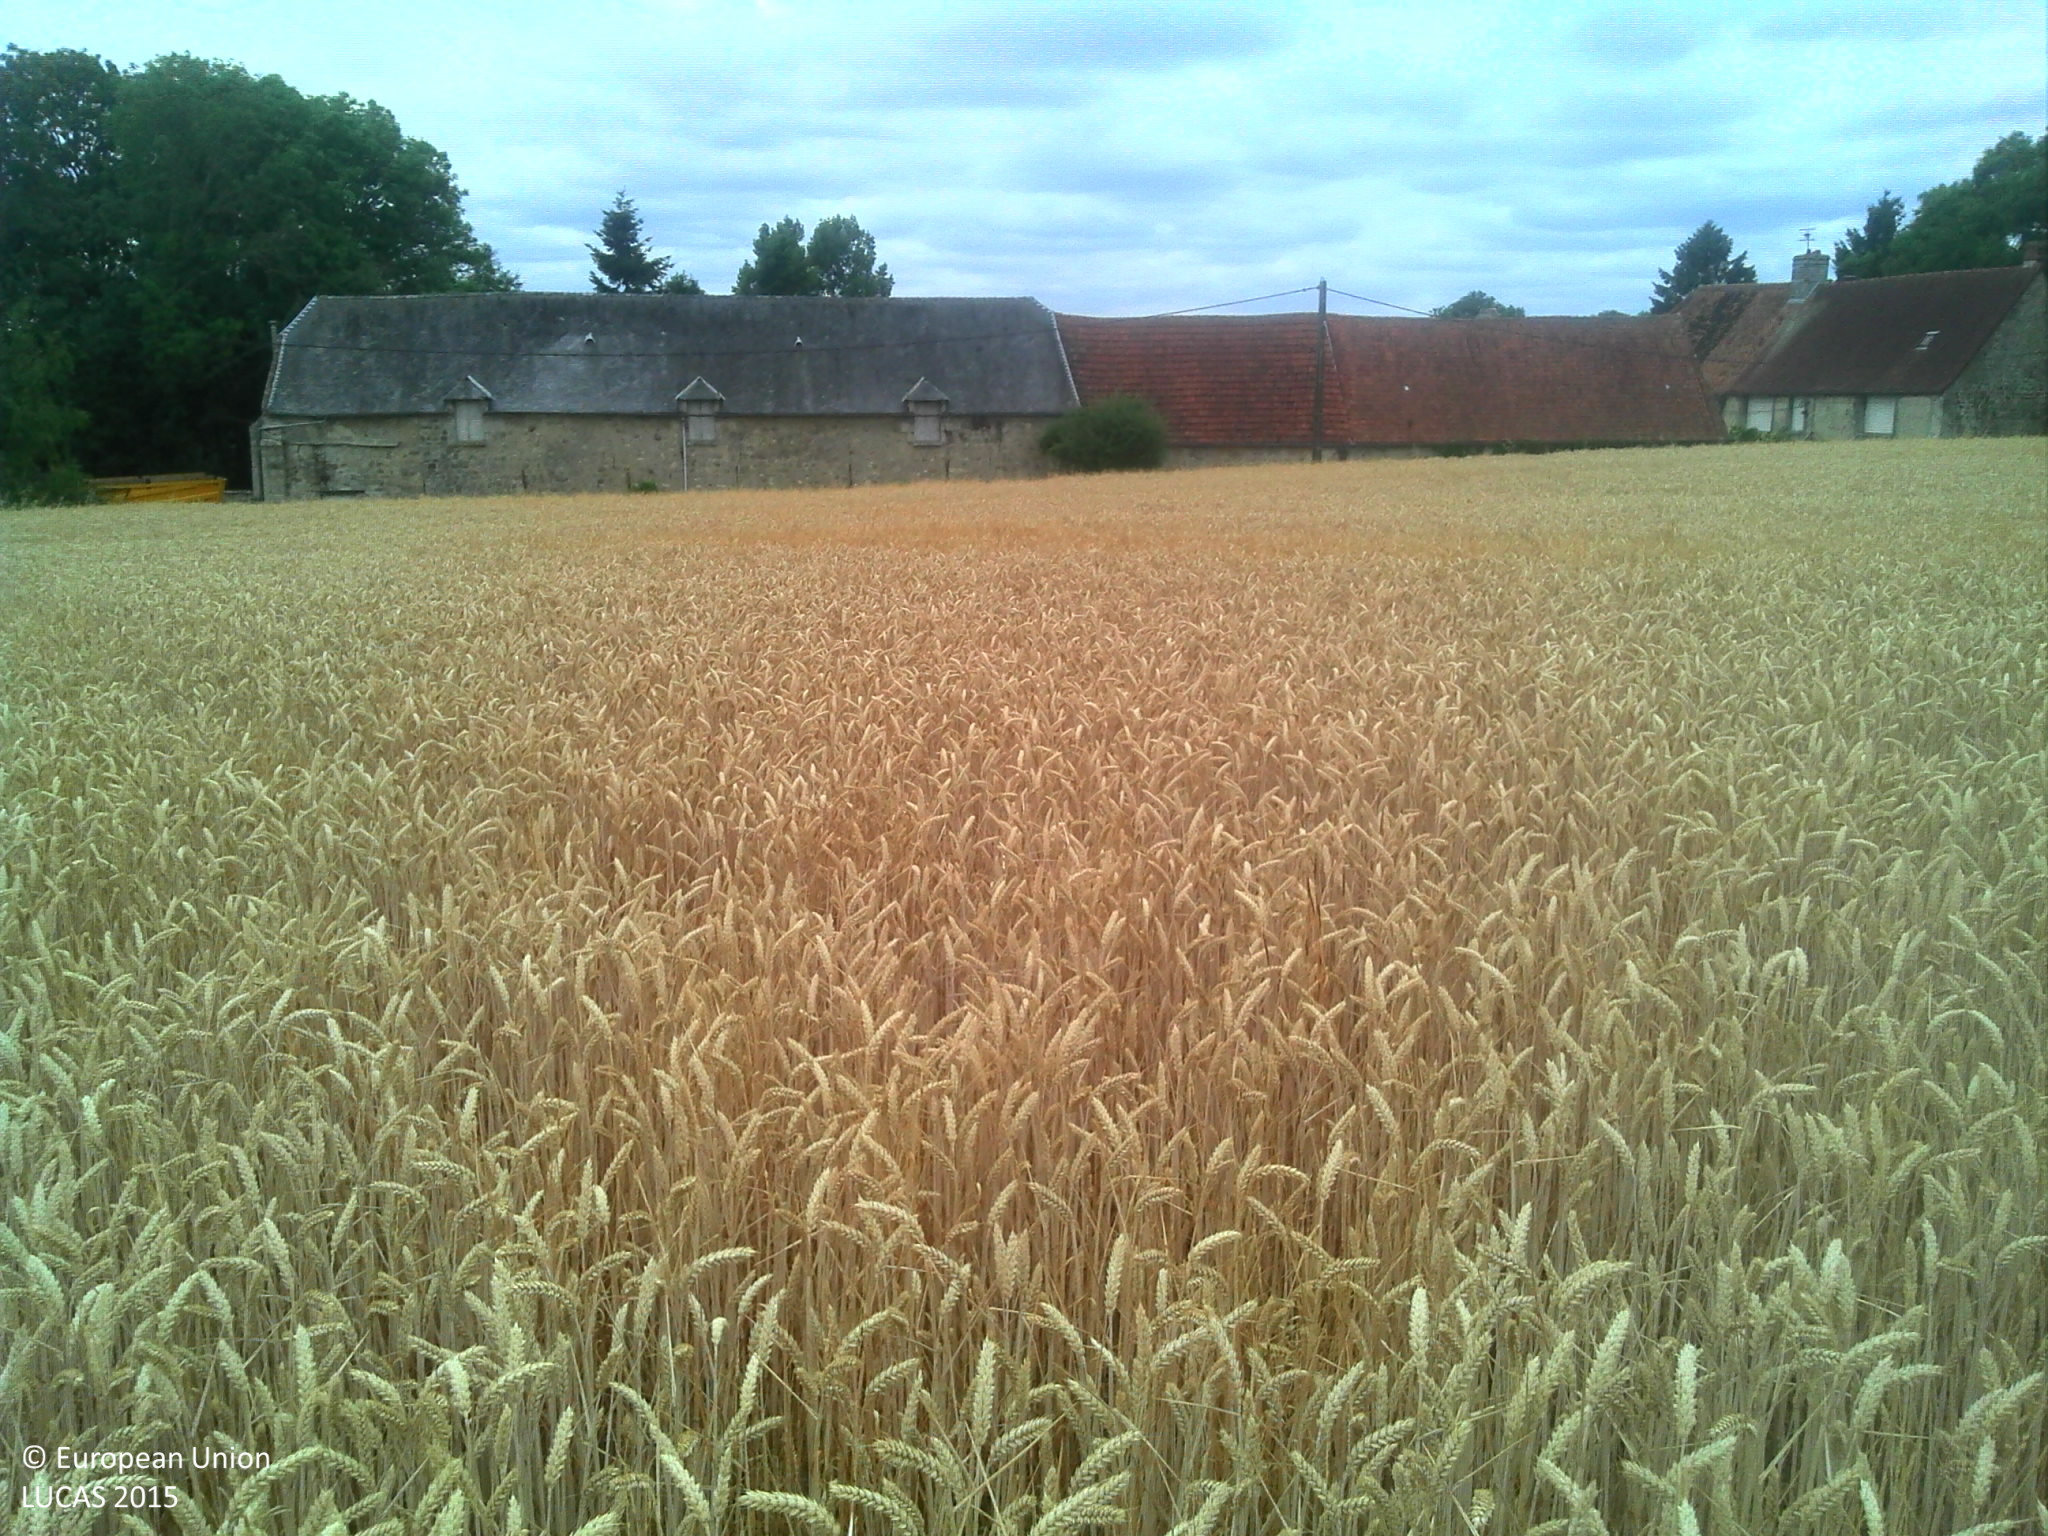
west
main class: Cropland
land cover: Common wheat
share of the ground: > 75 %
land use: Agriculture (excluding fallow land and kitchen gardens)
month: July
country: FR
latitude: 49.2311
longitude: 3.3320
